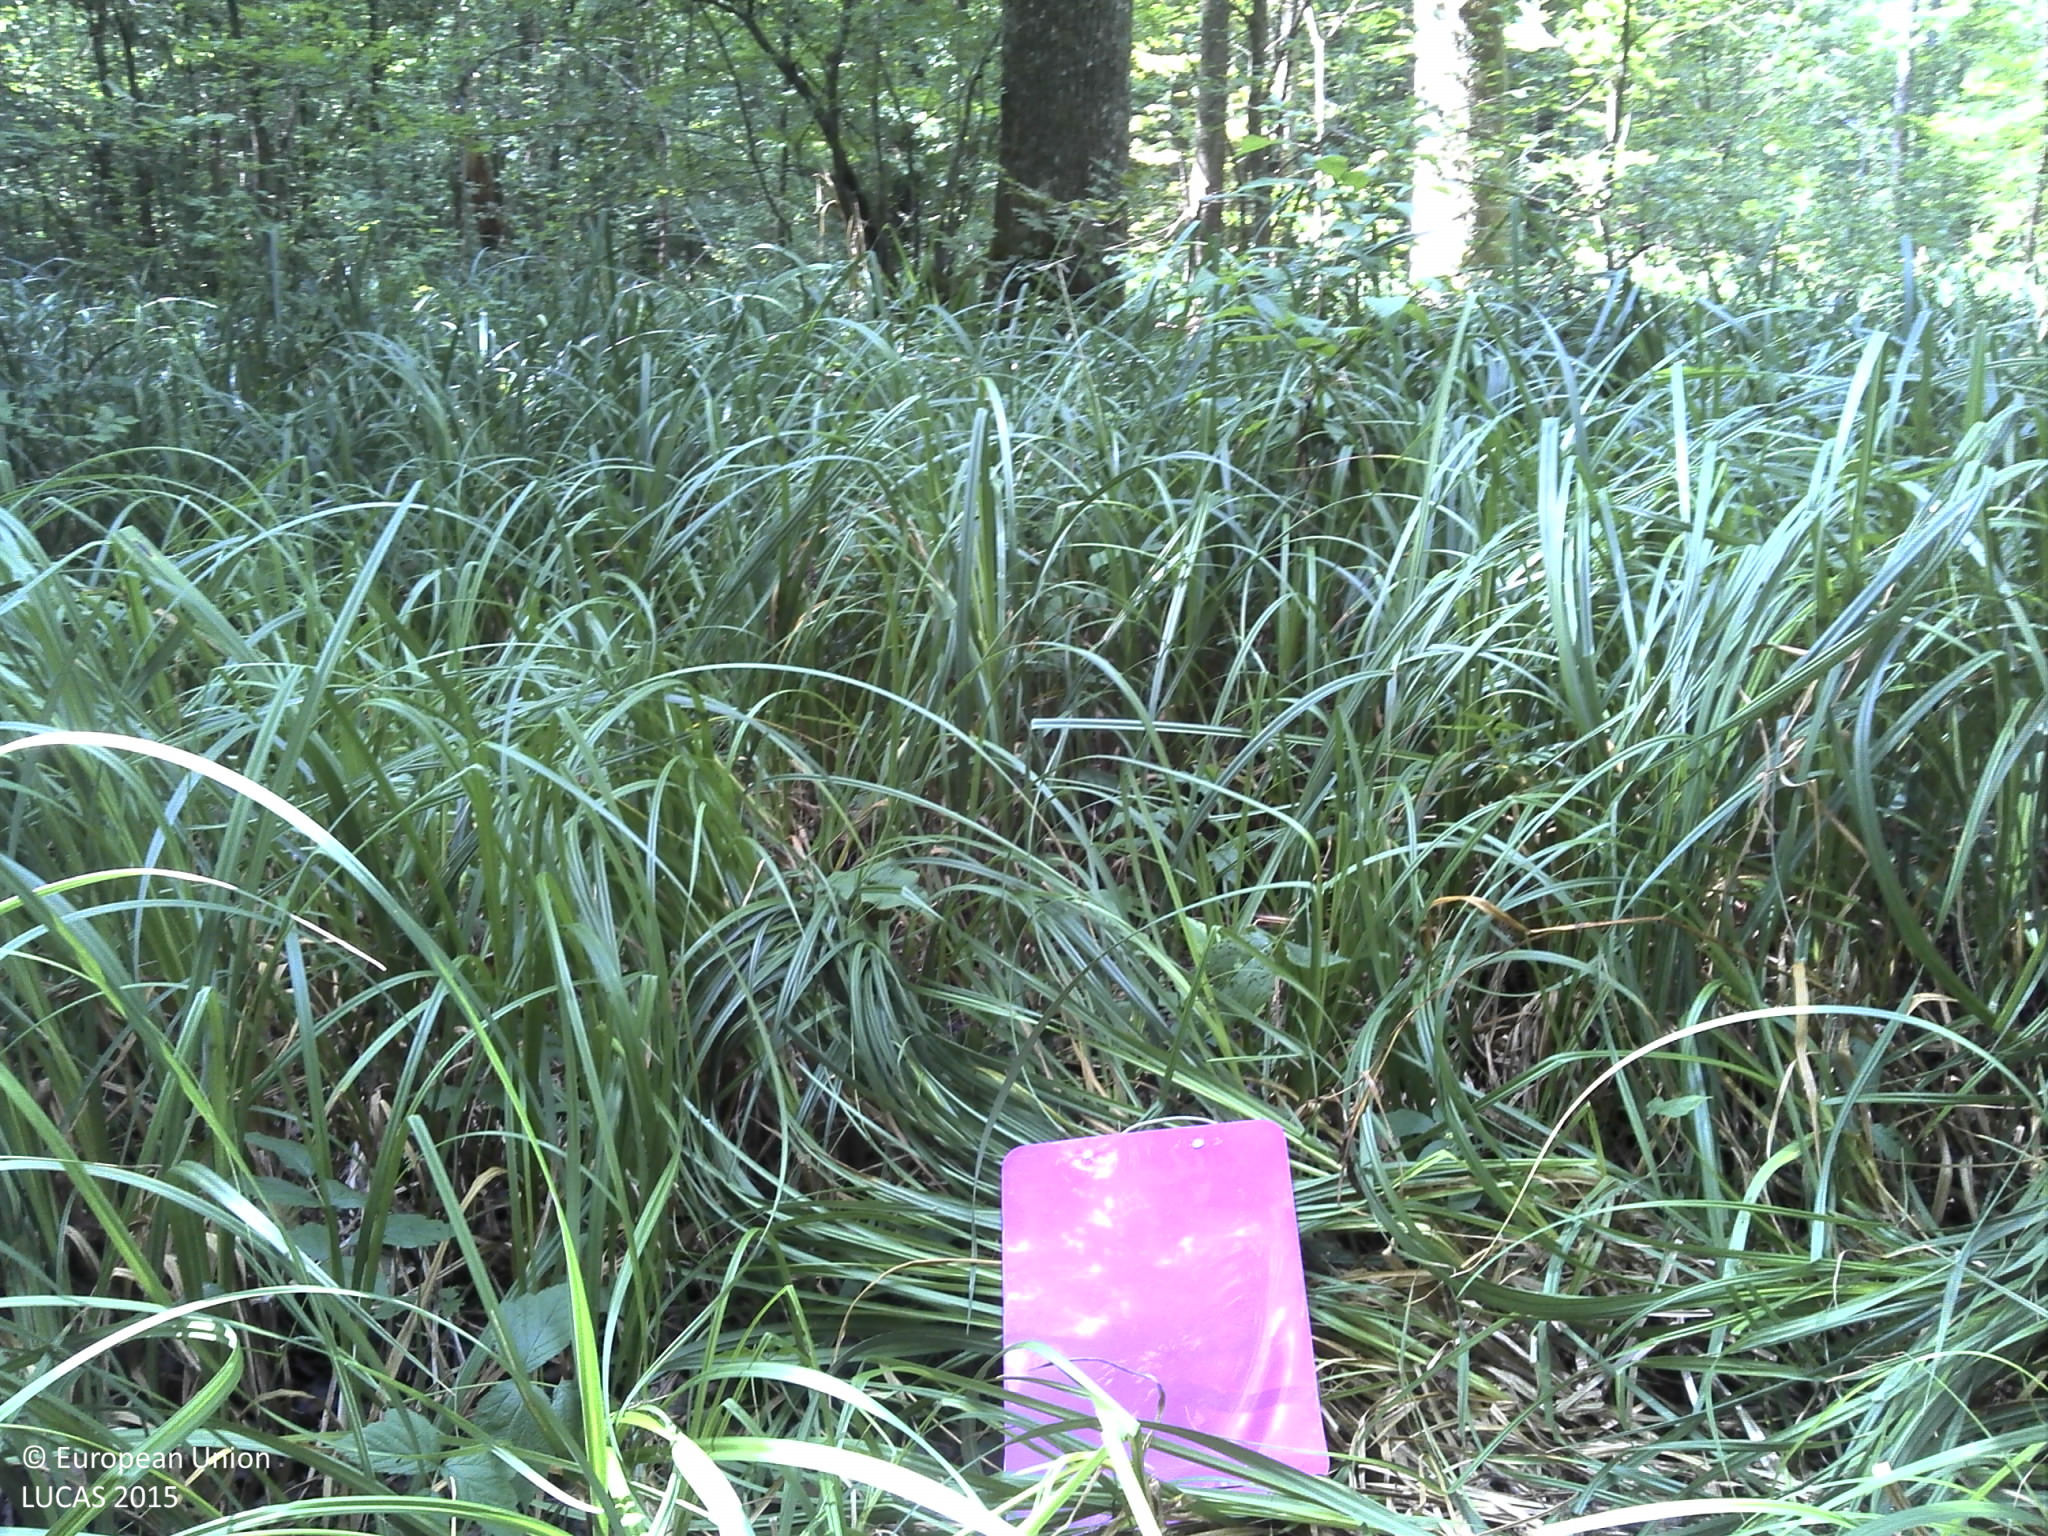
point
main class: Woodland
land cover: Broadleaved woodland
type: acidophilous oak and oak-birch forest
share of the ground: > 75 %
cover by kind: broadleaved forest trees 80 %, lichens and mosses 20 %
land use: Forestry
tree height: > 5 m
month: August
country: HR
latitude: 45.5021
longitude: 16.5125
